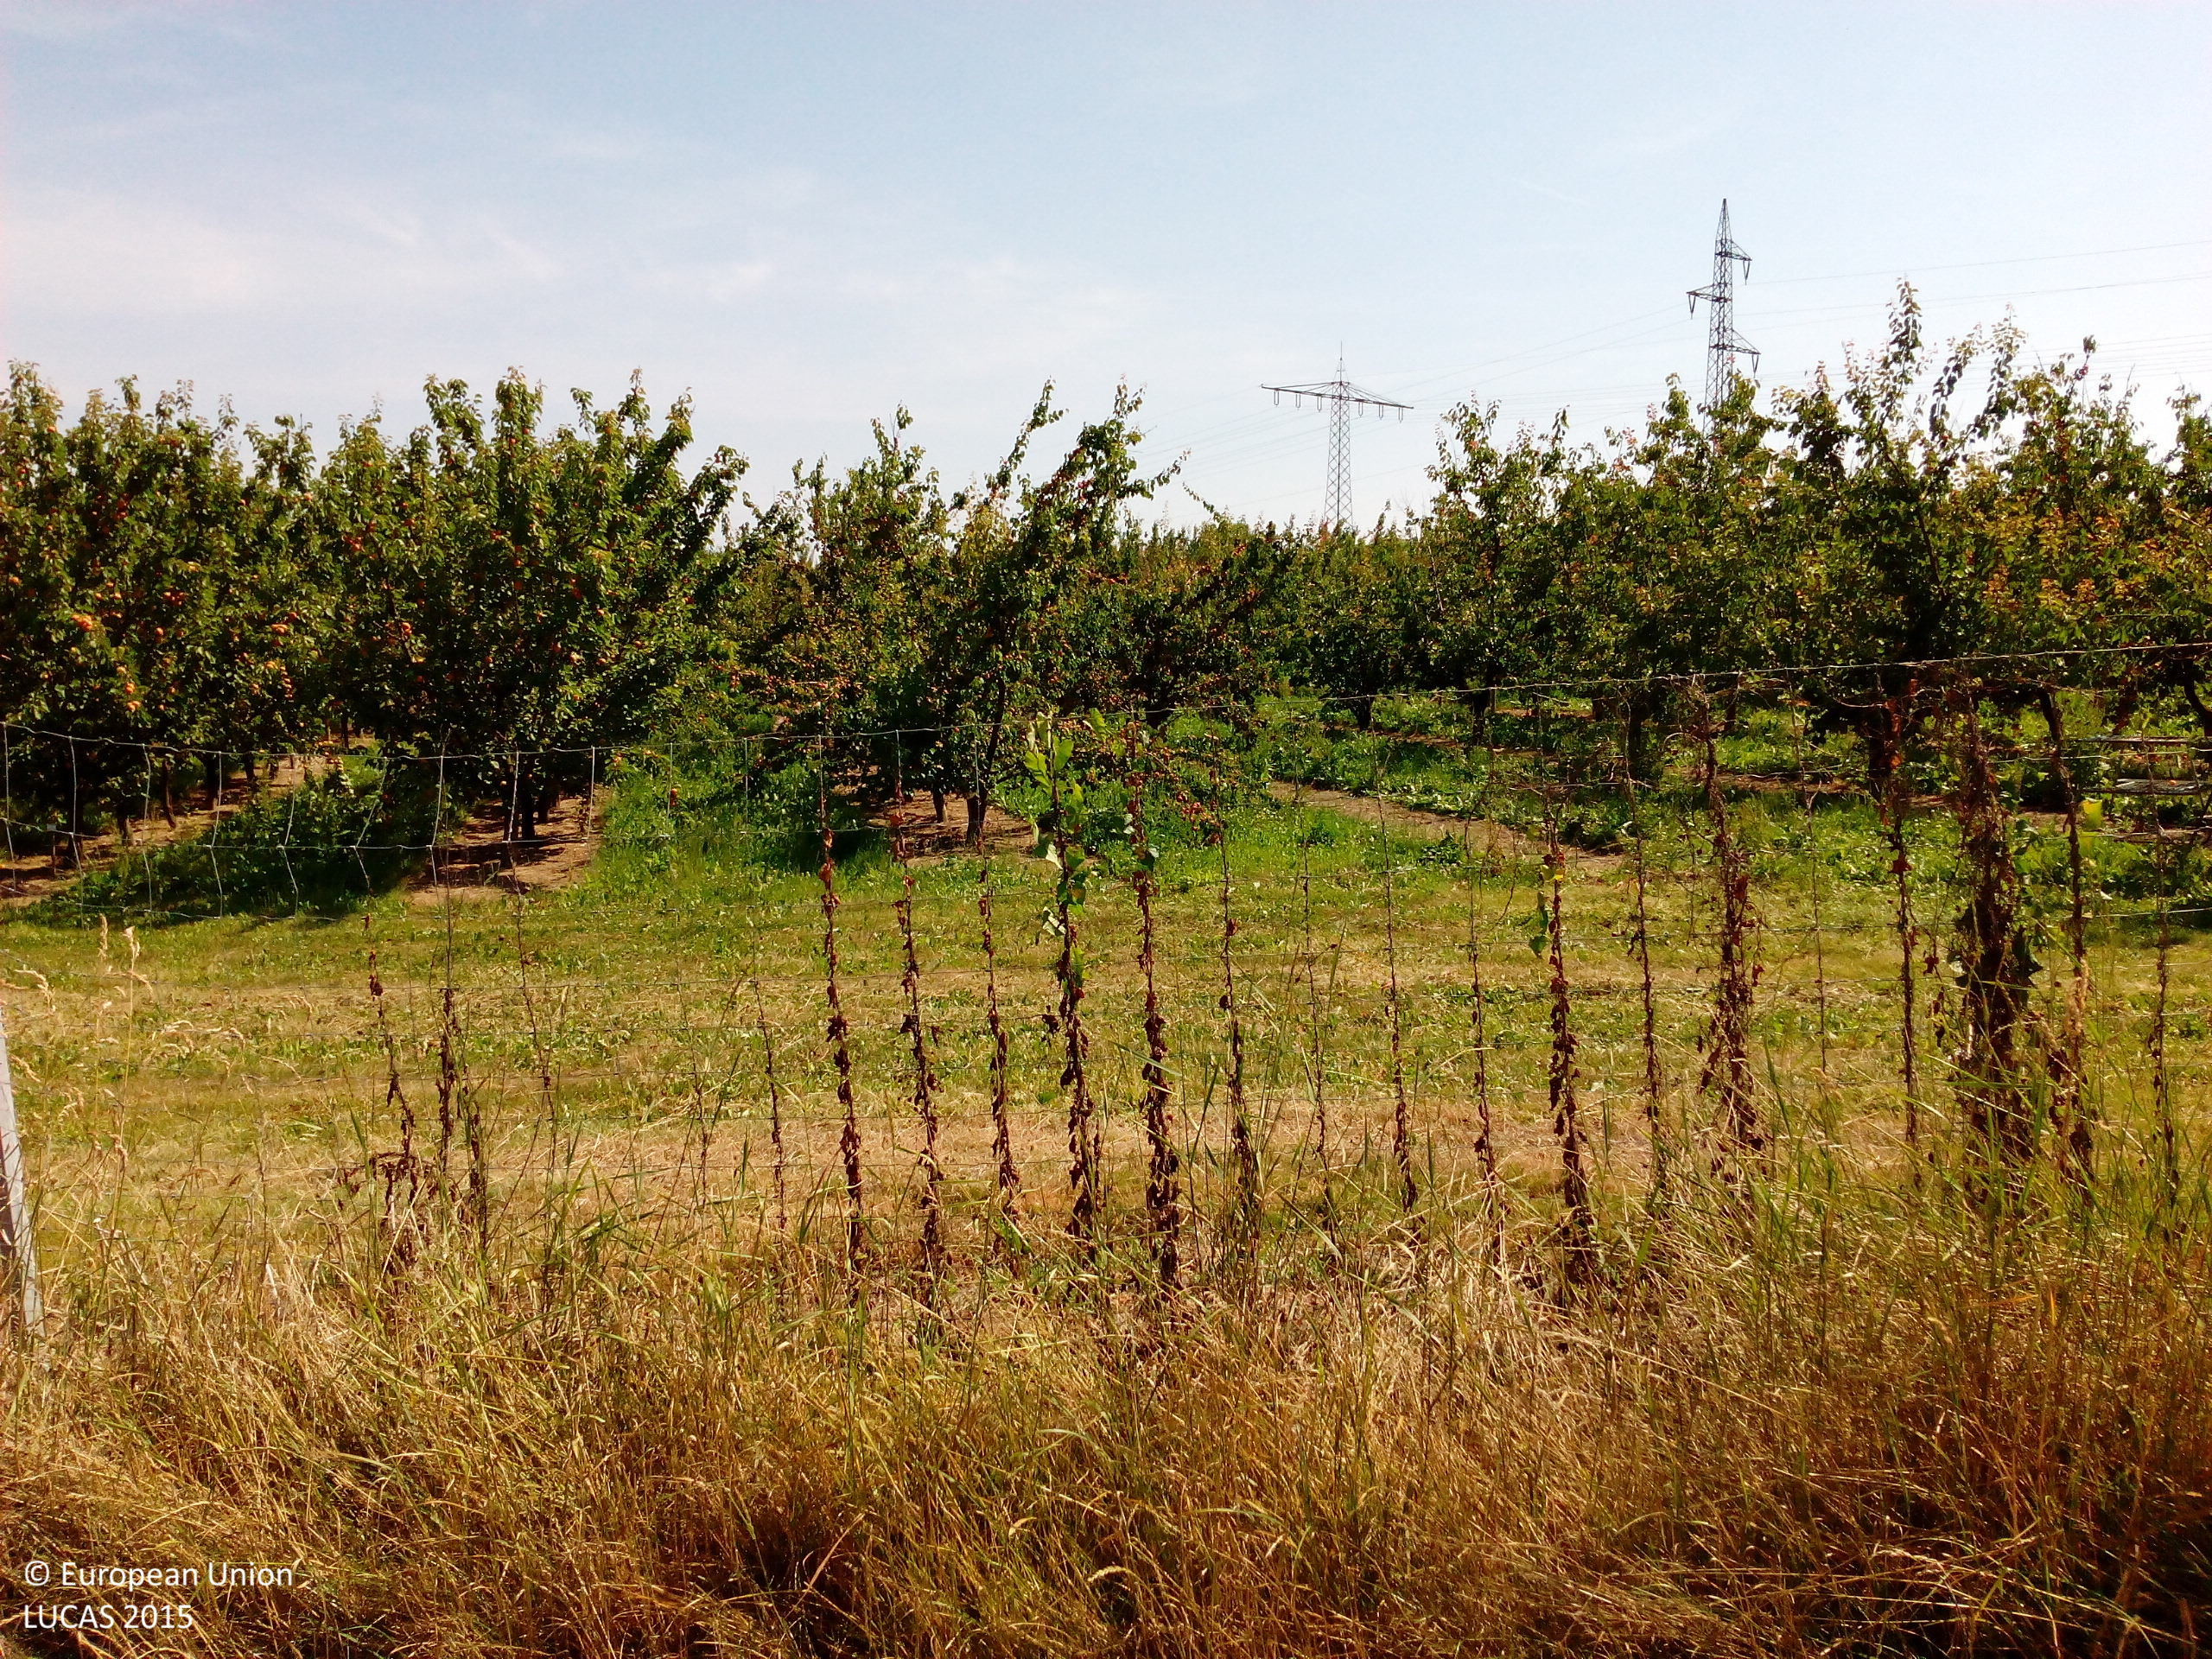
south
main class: Cropland
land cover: Common wheat
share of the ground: > 75 %
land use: Agriculture (excluding fallow land and kitchen gardens)
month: July
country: DE
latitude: 47.6577
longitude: 7.6181
